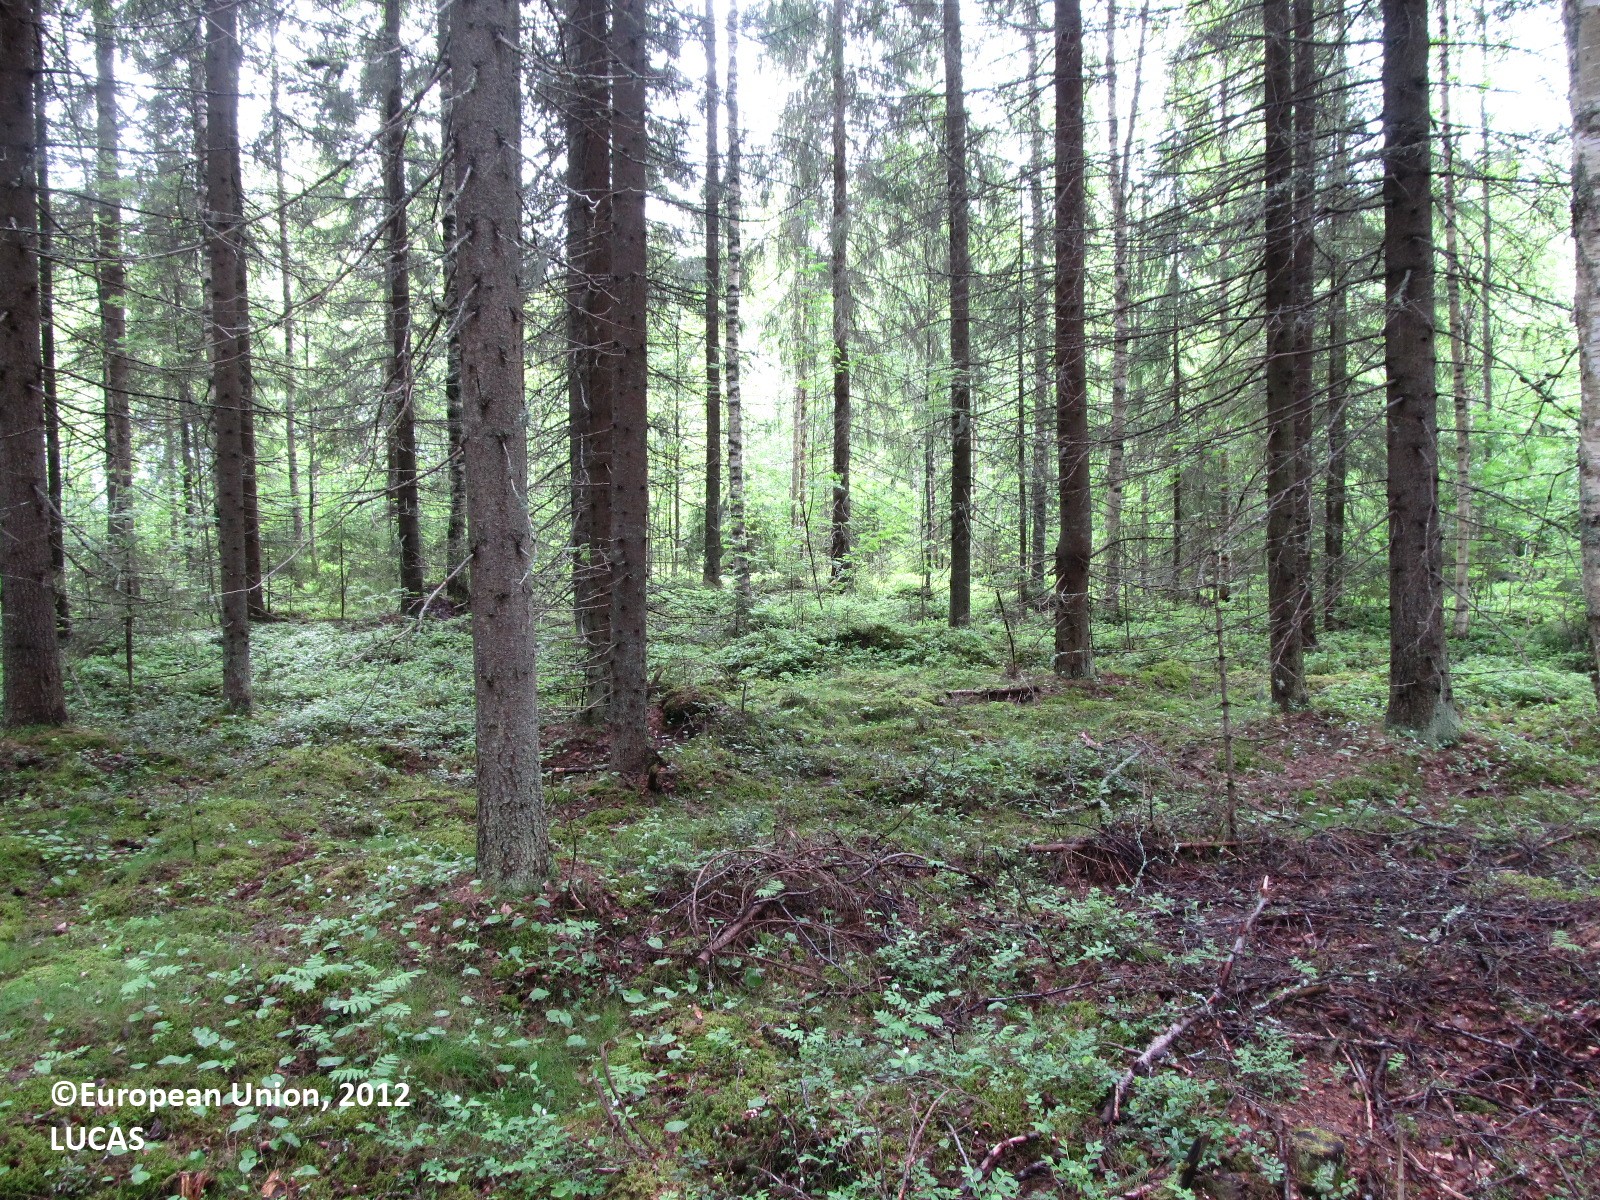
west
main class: Woodland
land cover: Spruce dominated coniferous woodland
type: boreal forest
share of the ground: 25 - 50 %
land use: Forestry
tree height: > 5 m
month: June
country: FI
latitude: 62.9249
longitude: 28.1643
